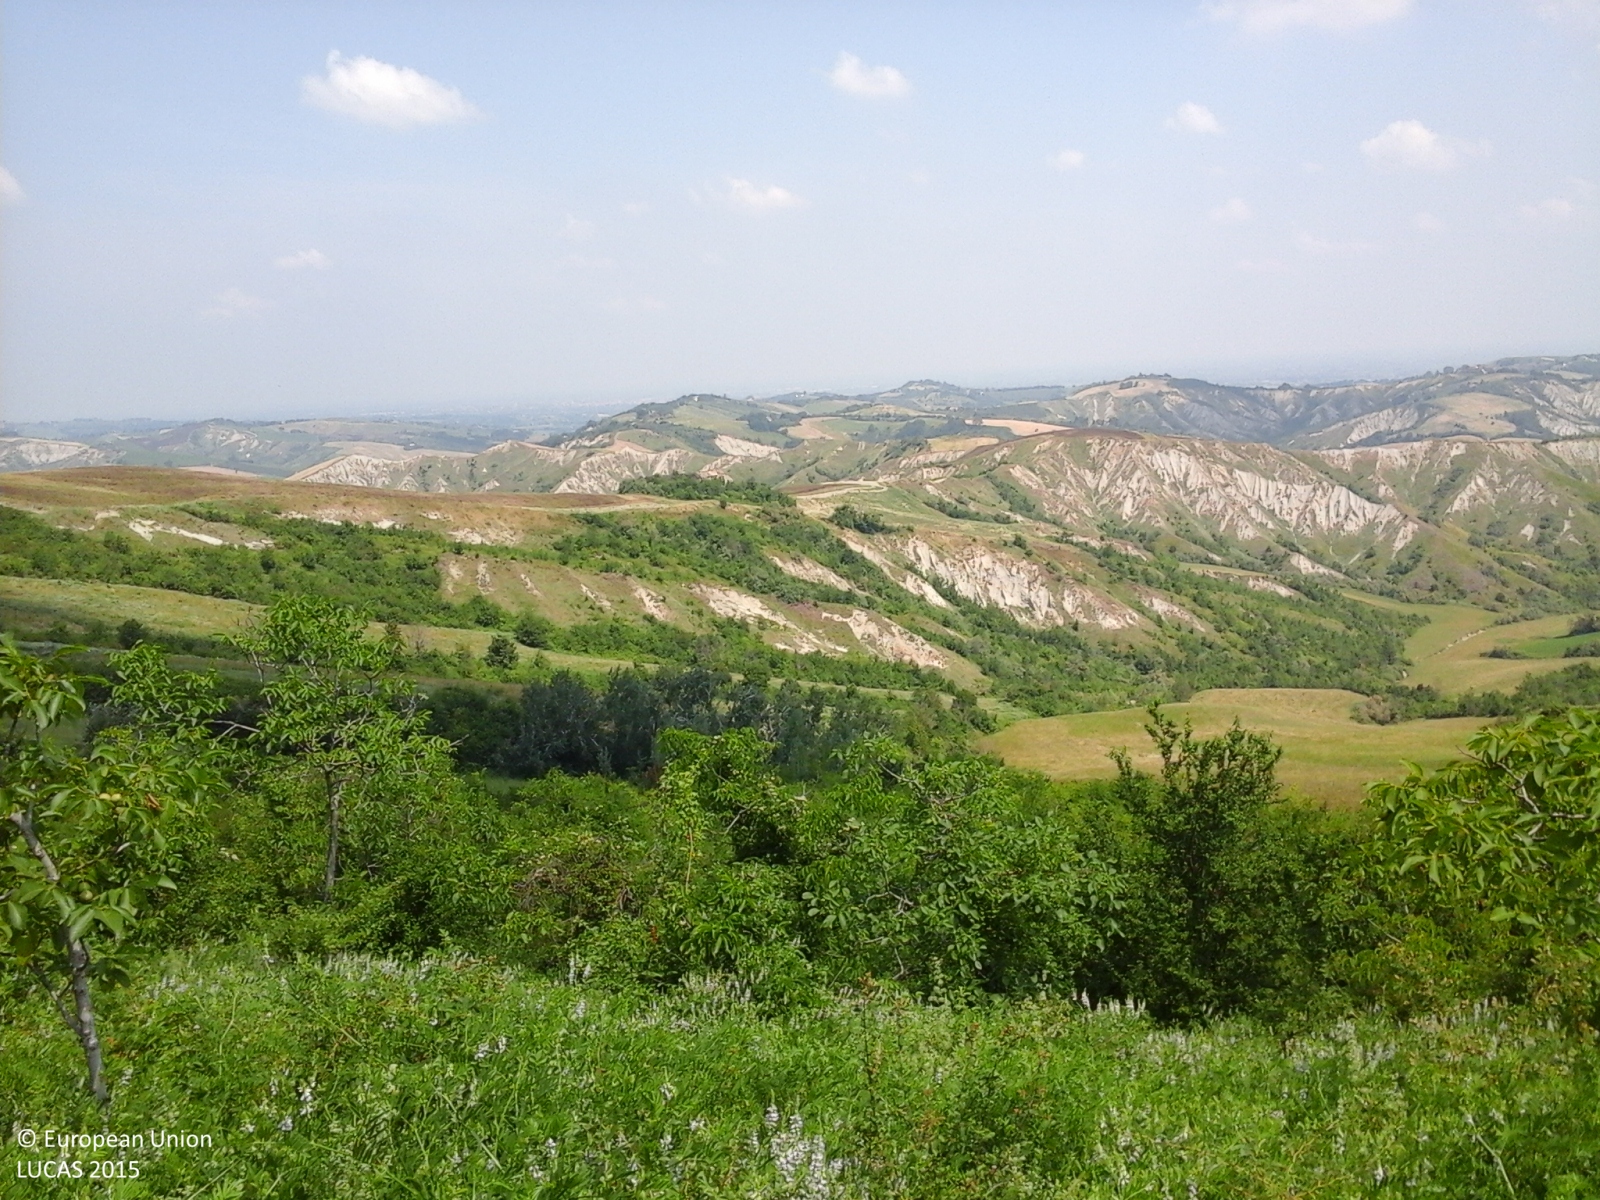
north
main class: Cropland
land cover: Nuts trees
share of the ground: 25 - 50 %
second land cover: Spontaneously vegetated surfaces
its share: > 75 %
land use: Abandoned areas
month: June
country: IT
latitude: 44.1706
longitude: 11.9091
